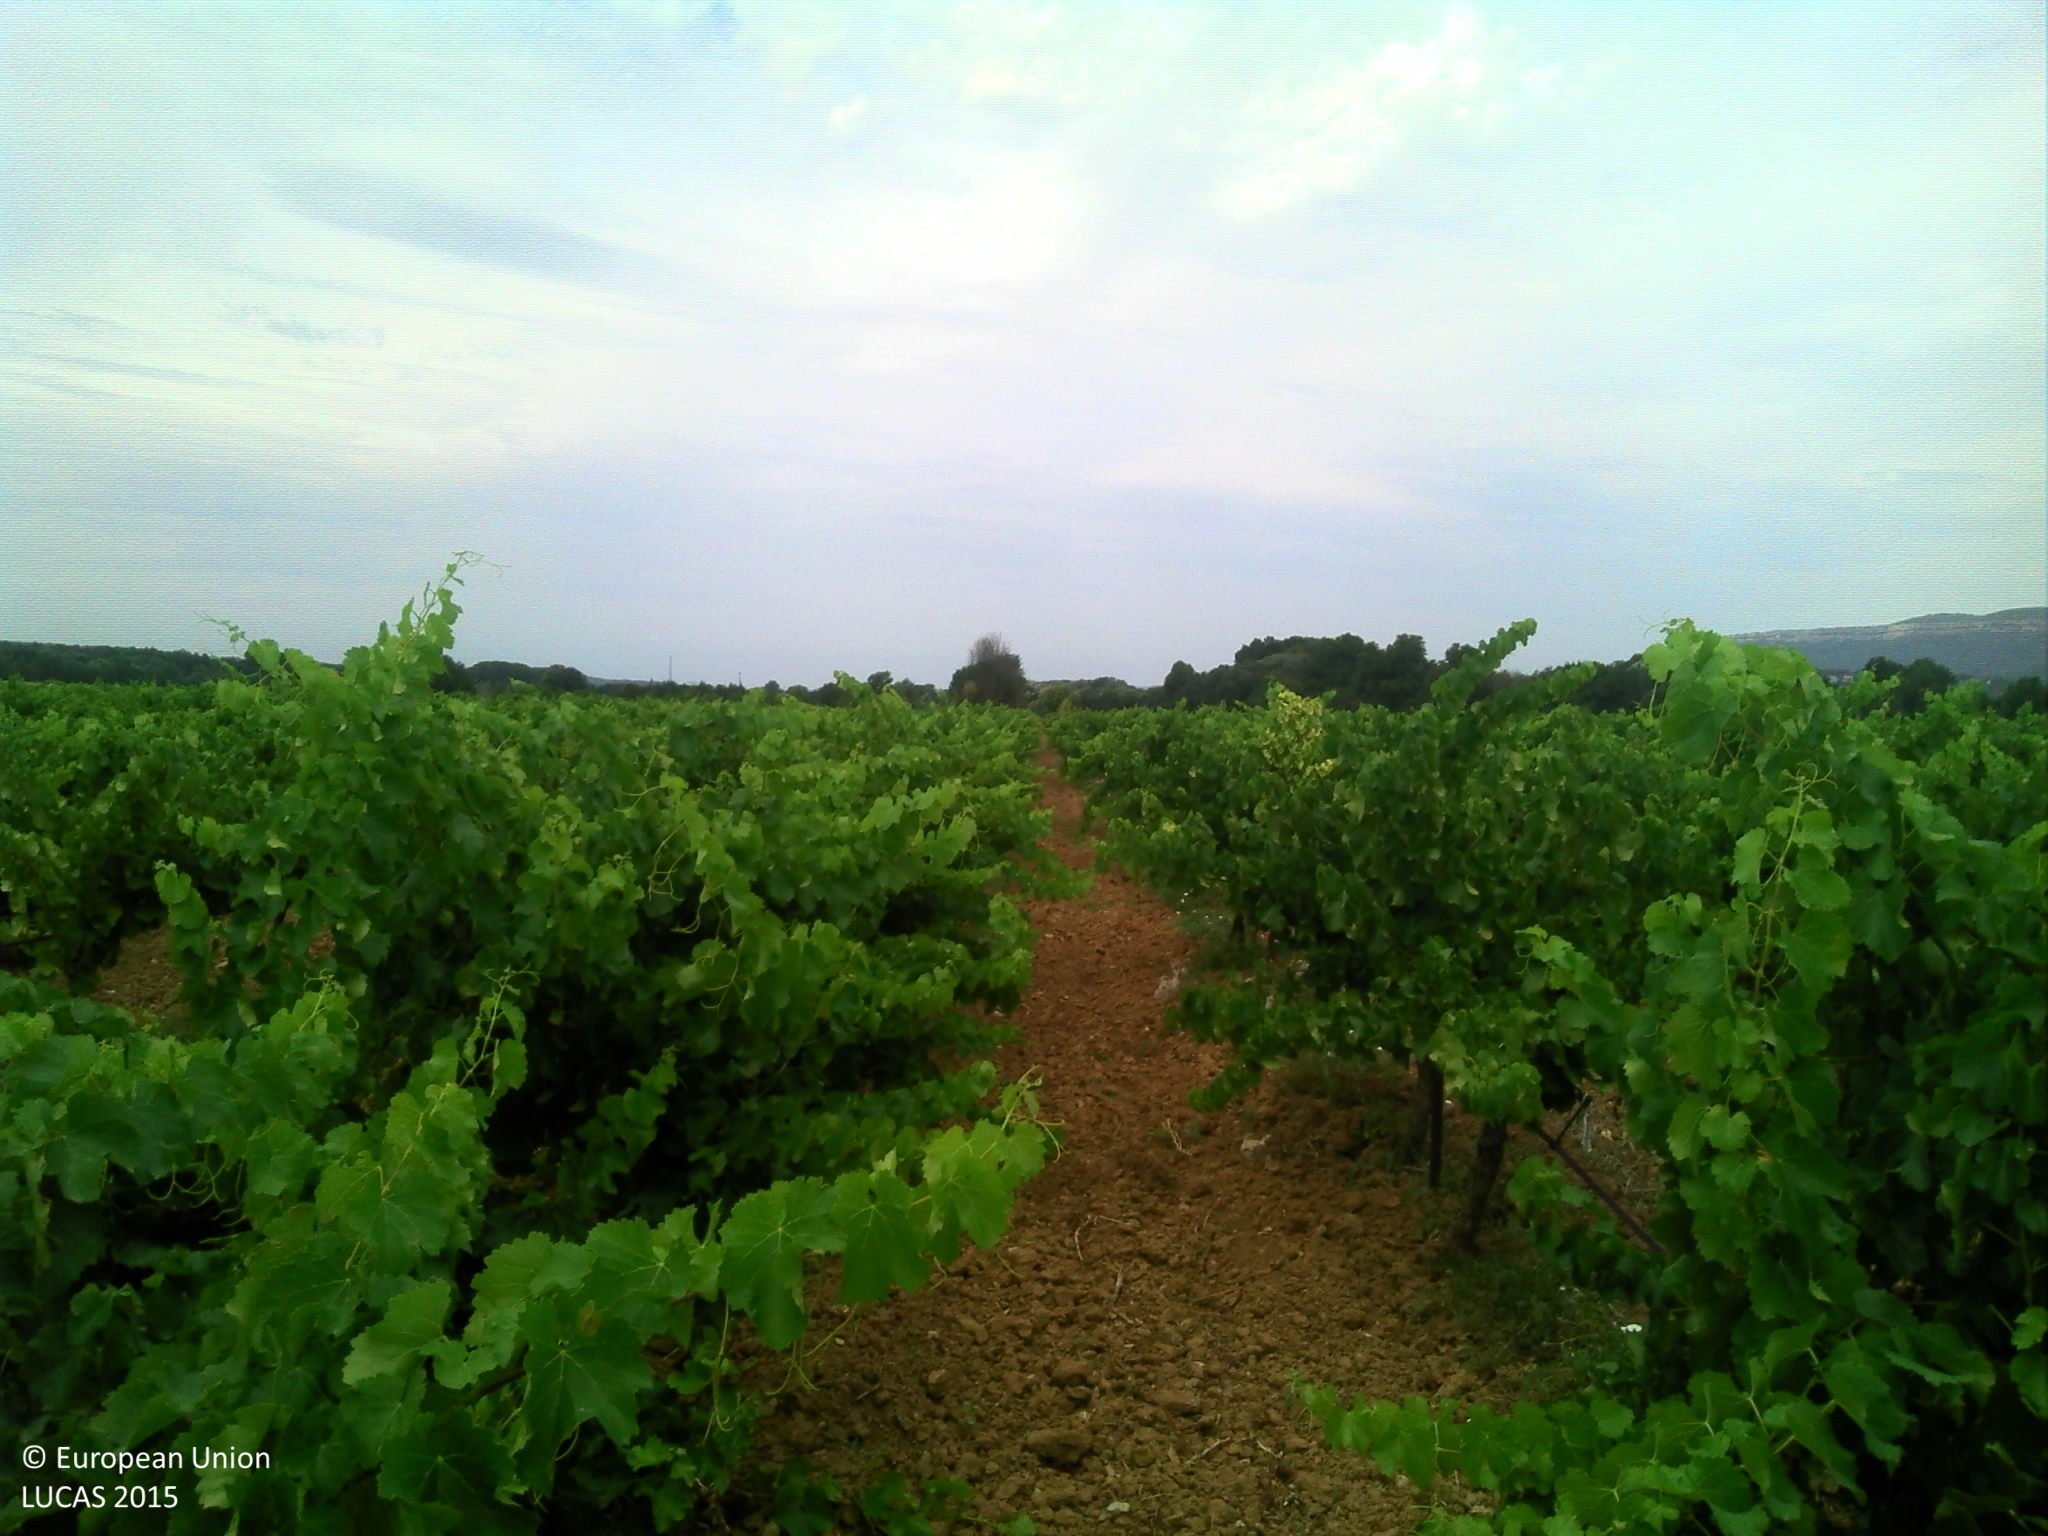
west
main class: Cropland
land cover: Vineyards
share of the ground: > 75 %
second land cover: Other bare soil
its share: > 75 %
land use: Agriculture (excluding fallow land and kitchen gardens)
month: August
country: FR
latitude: 43.4643
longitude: 5.6465
